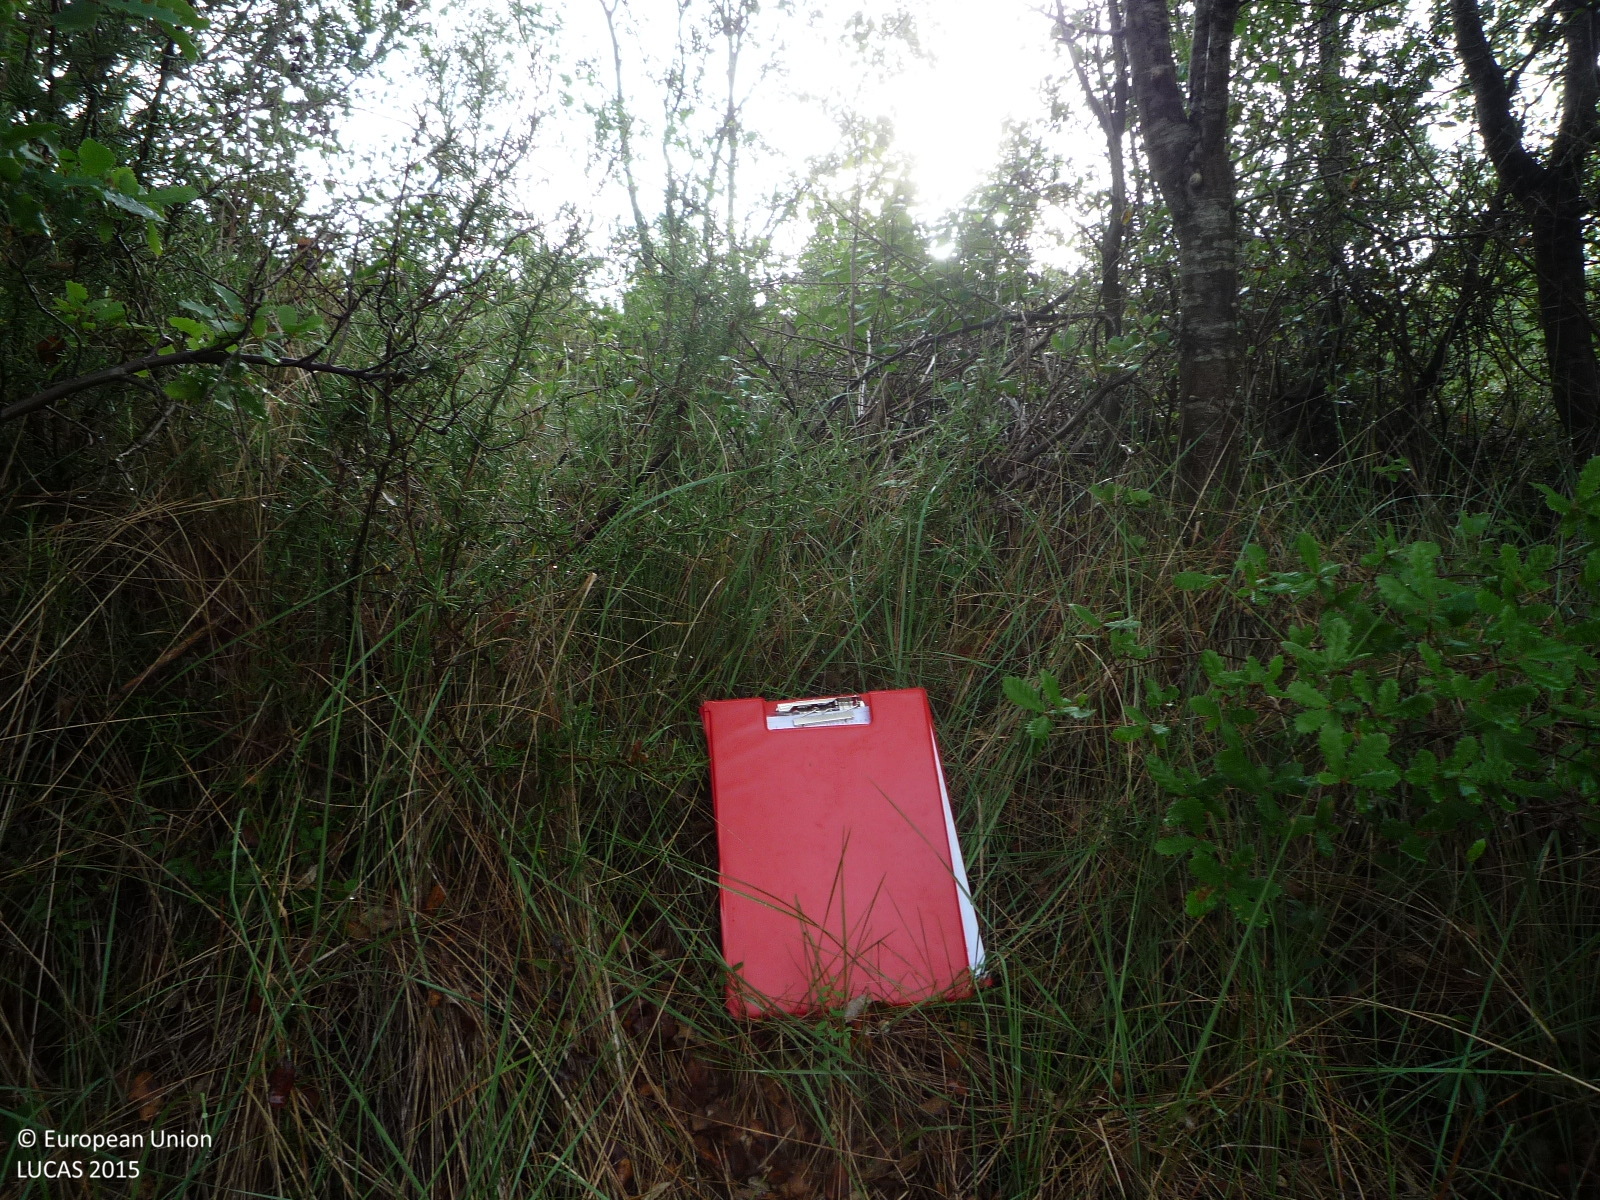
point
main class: Woodland
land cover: Broadleaved woodland
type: broadleaved evergreen forest
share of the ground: > 75 %
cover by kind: broadleaved forest trees 80 %, shrubs 20 %
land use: Semi-natural and natural areas not in use
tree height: < 5 m
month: June
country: ES
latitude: 42.0055
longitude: 1.9363
